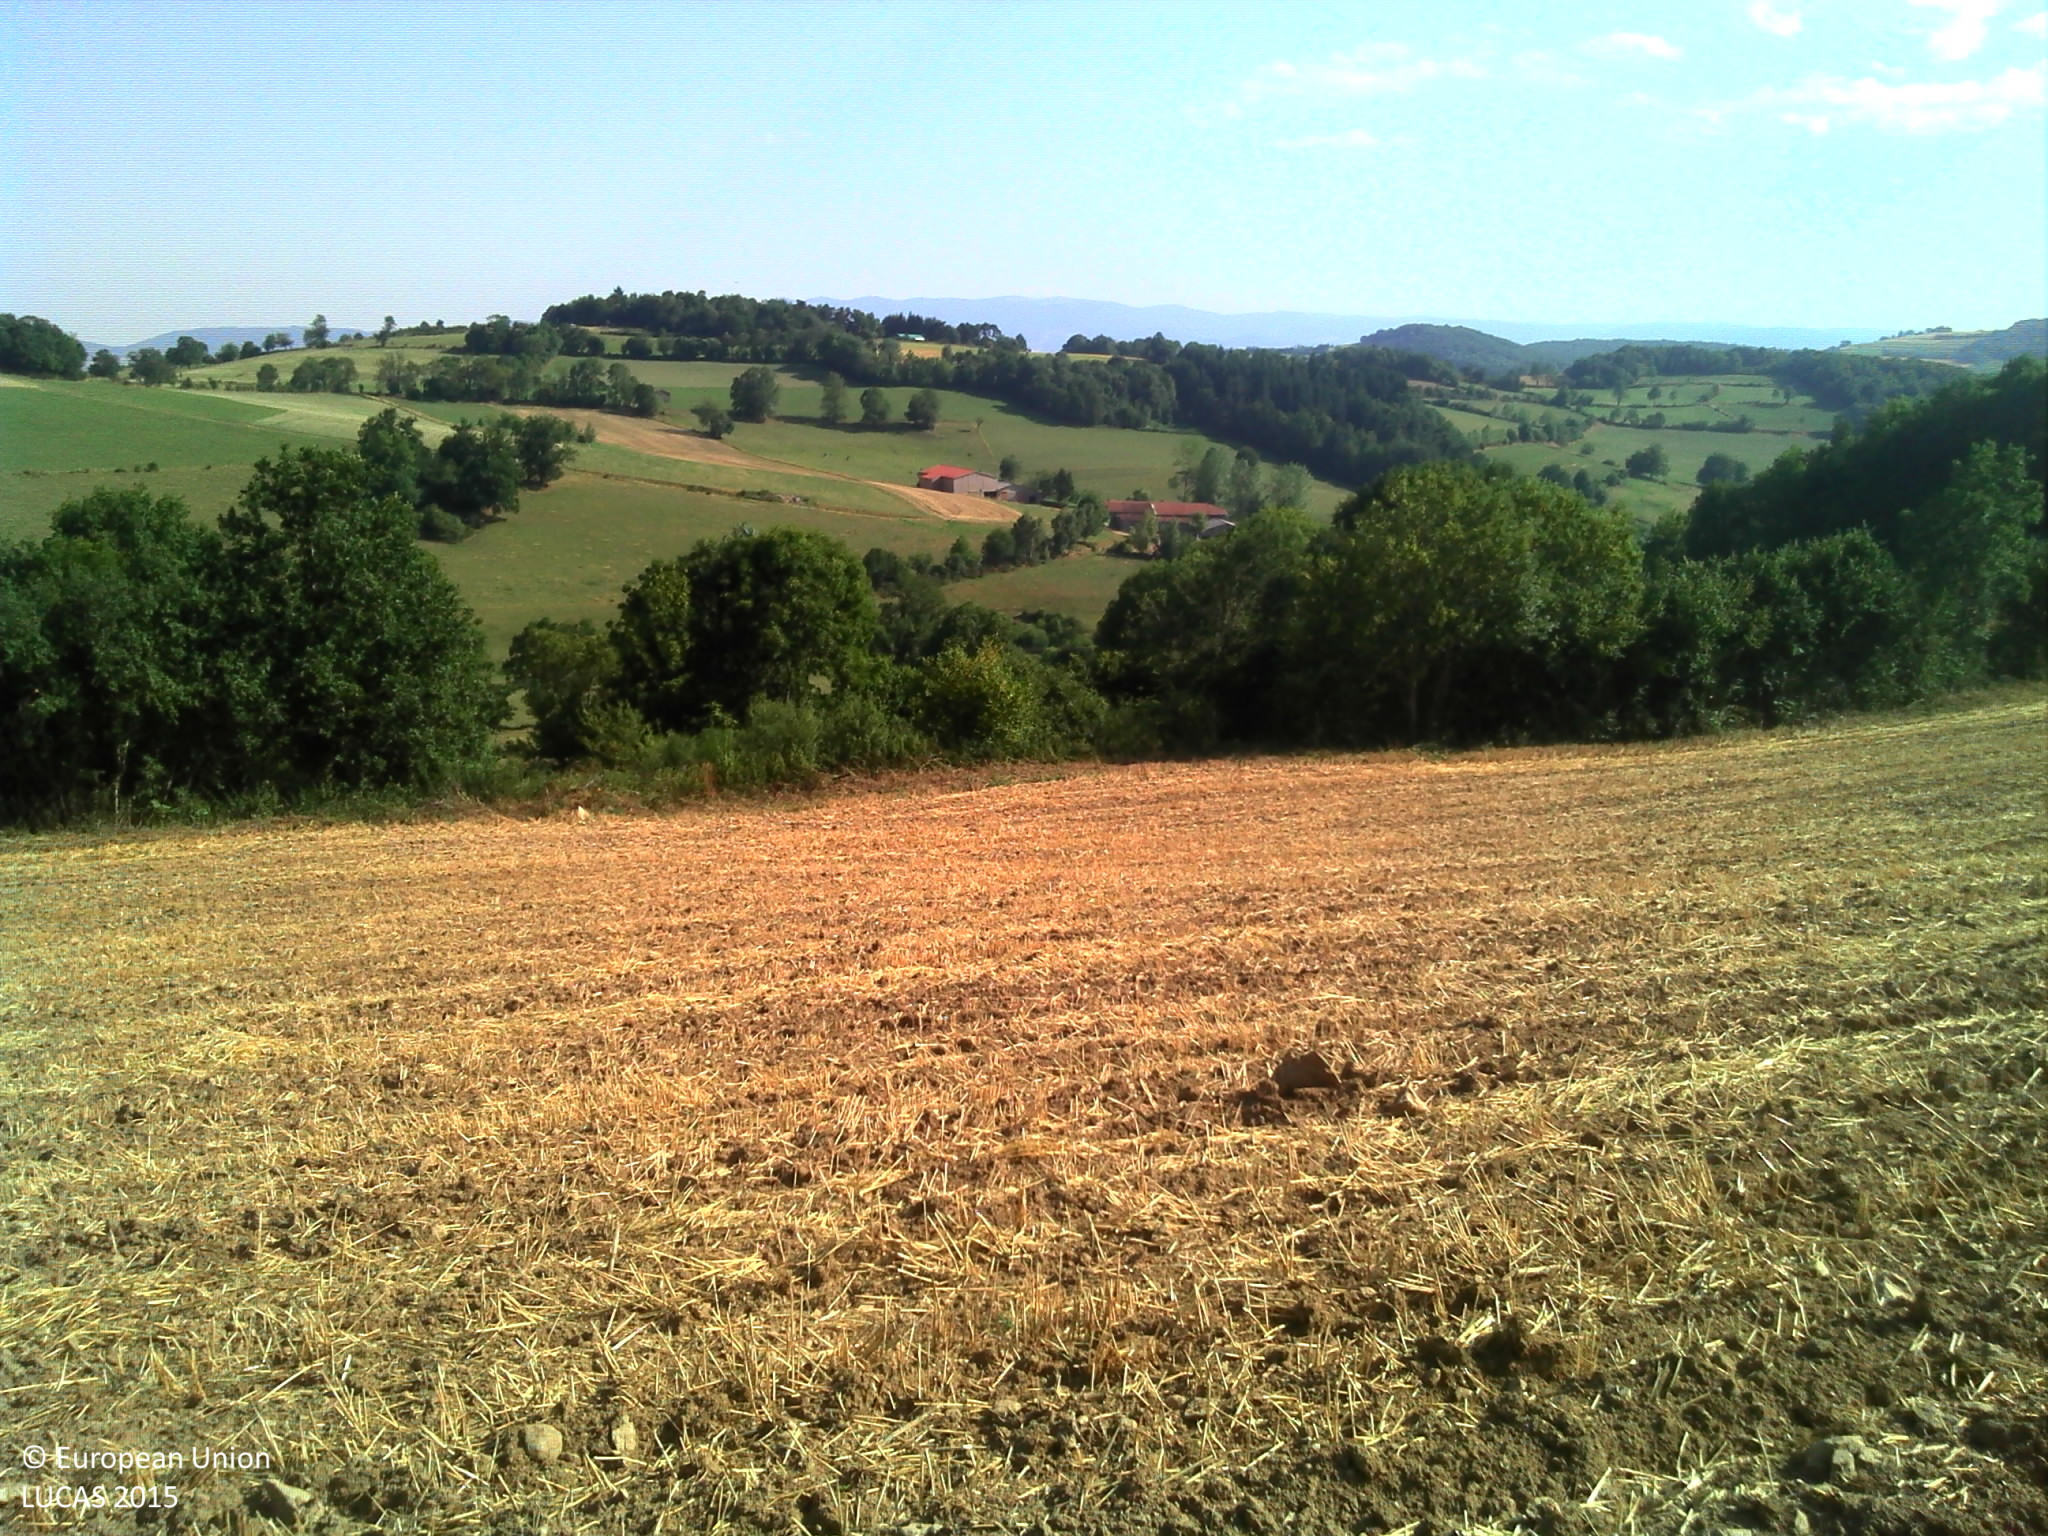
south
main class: Cropland
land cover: Durum wheat
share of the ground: 10 - 25 %
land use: Agriculture (excluding fallow land and kitchen gardens)
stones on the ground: 10 - 25 %
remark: Harvested field
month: August
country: FR
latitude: 45.6180
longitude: 4.5788
